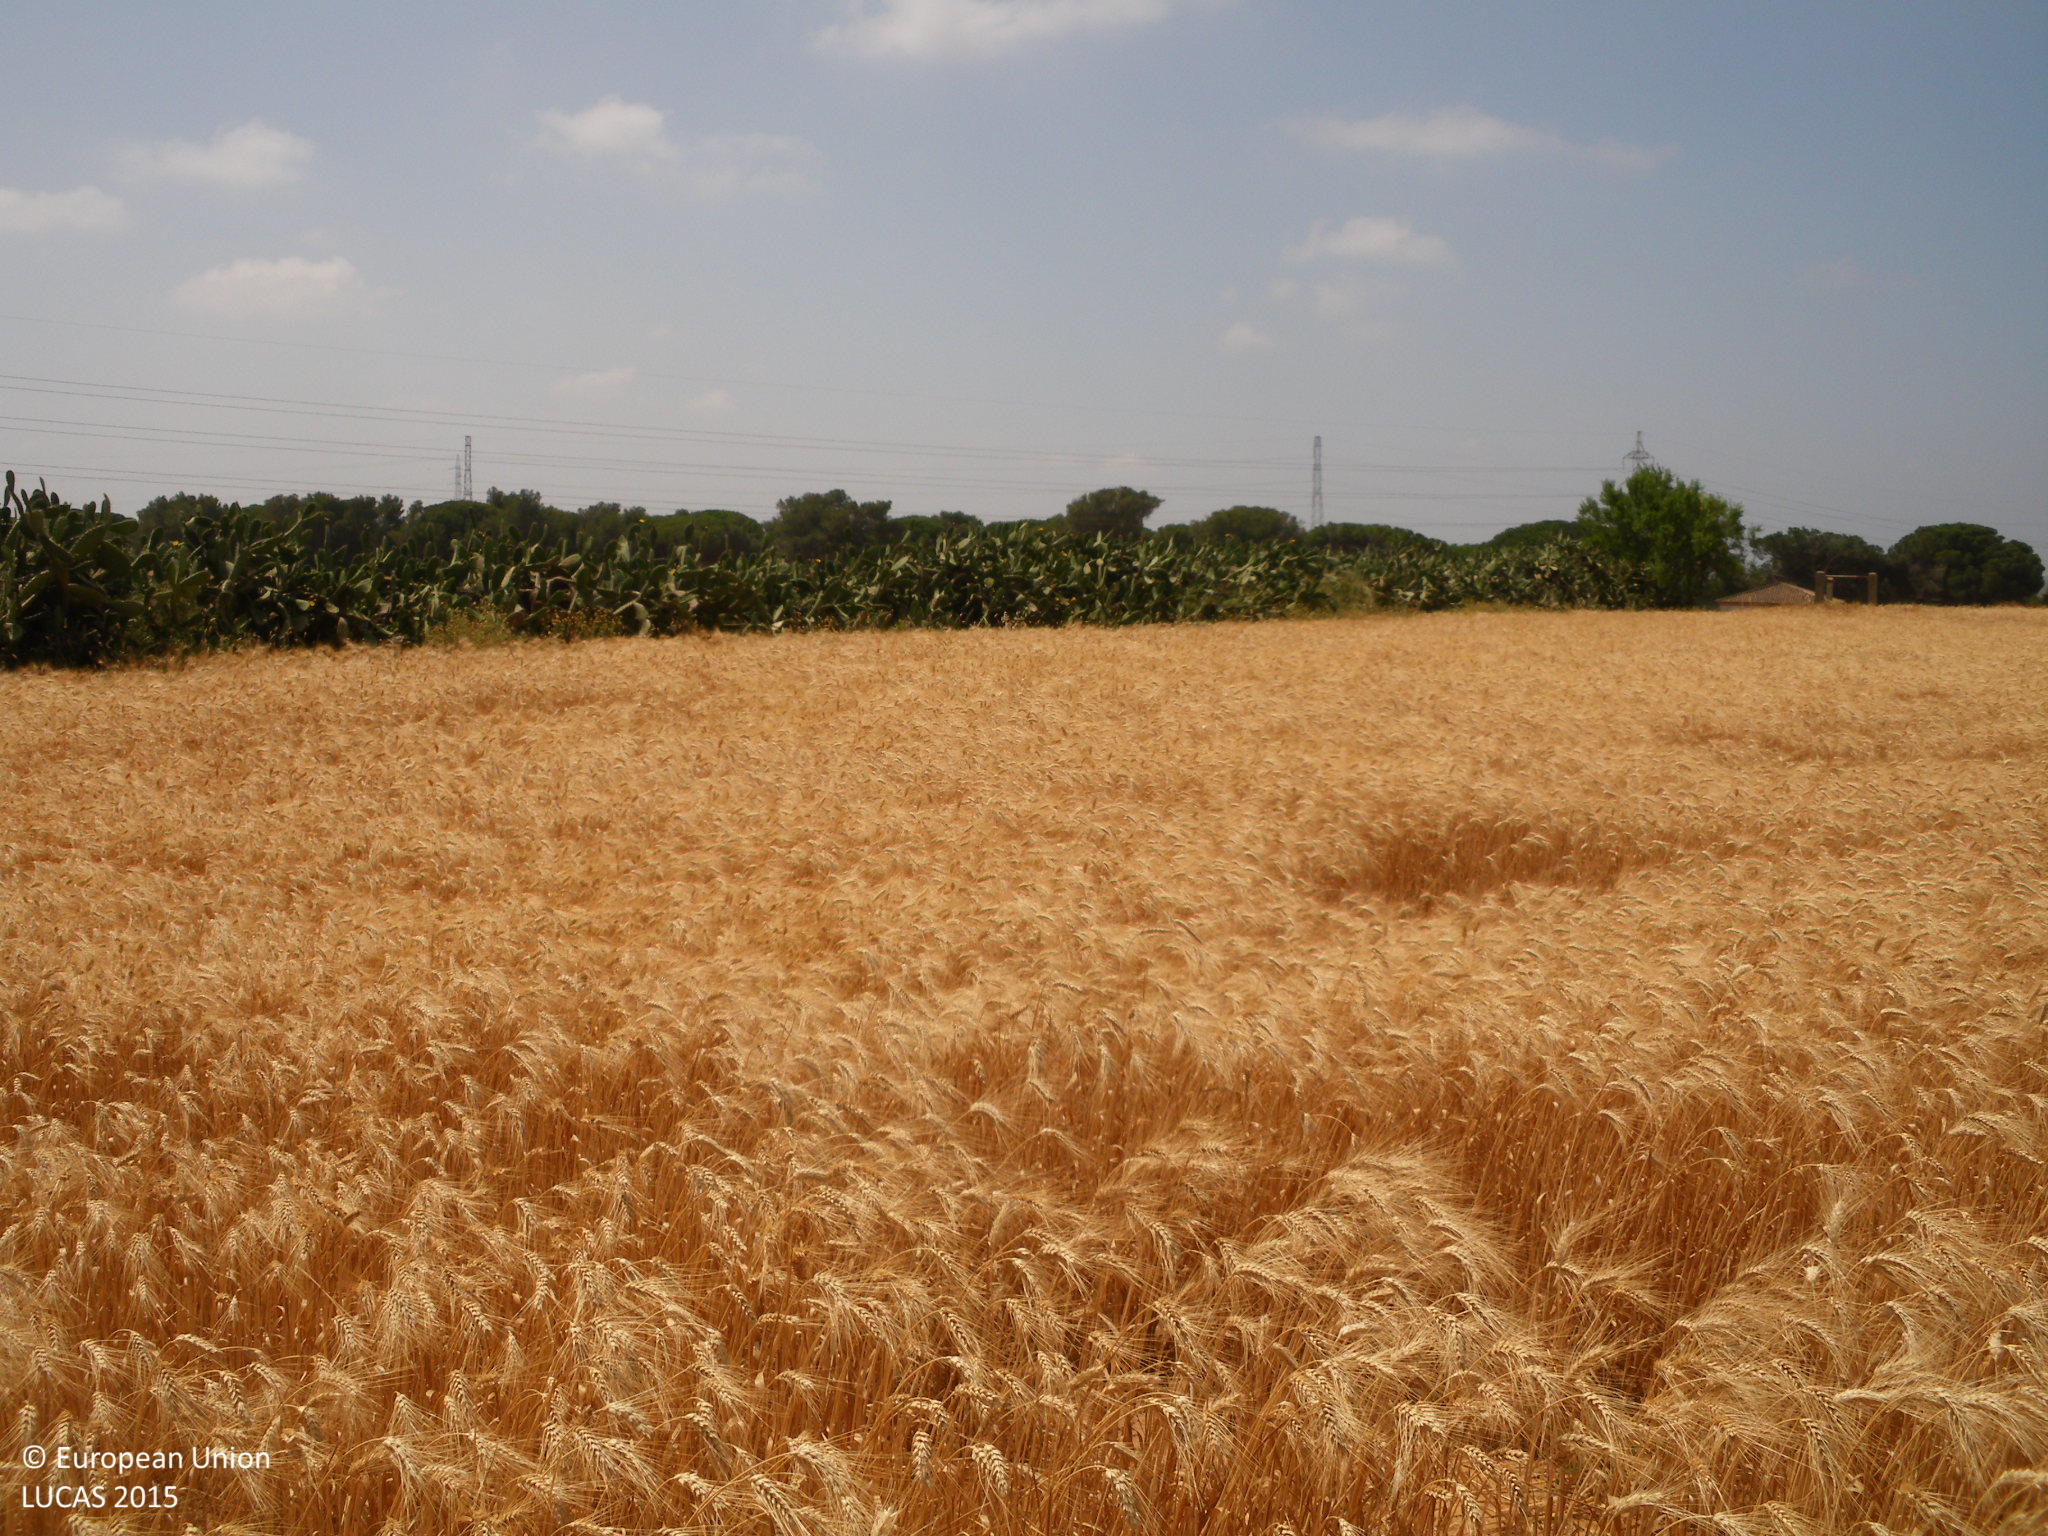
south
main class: Cropland
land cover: Durum wheat
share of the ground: > 75 %
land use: Agriculture (excluding fallow land and kitchen gardens)
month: May
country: ES
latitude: 36.5239
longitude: -6.1466
